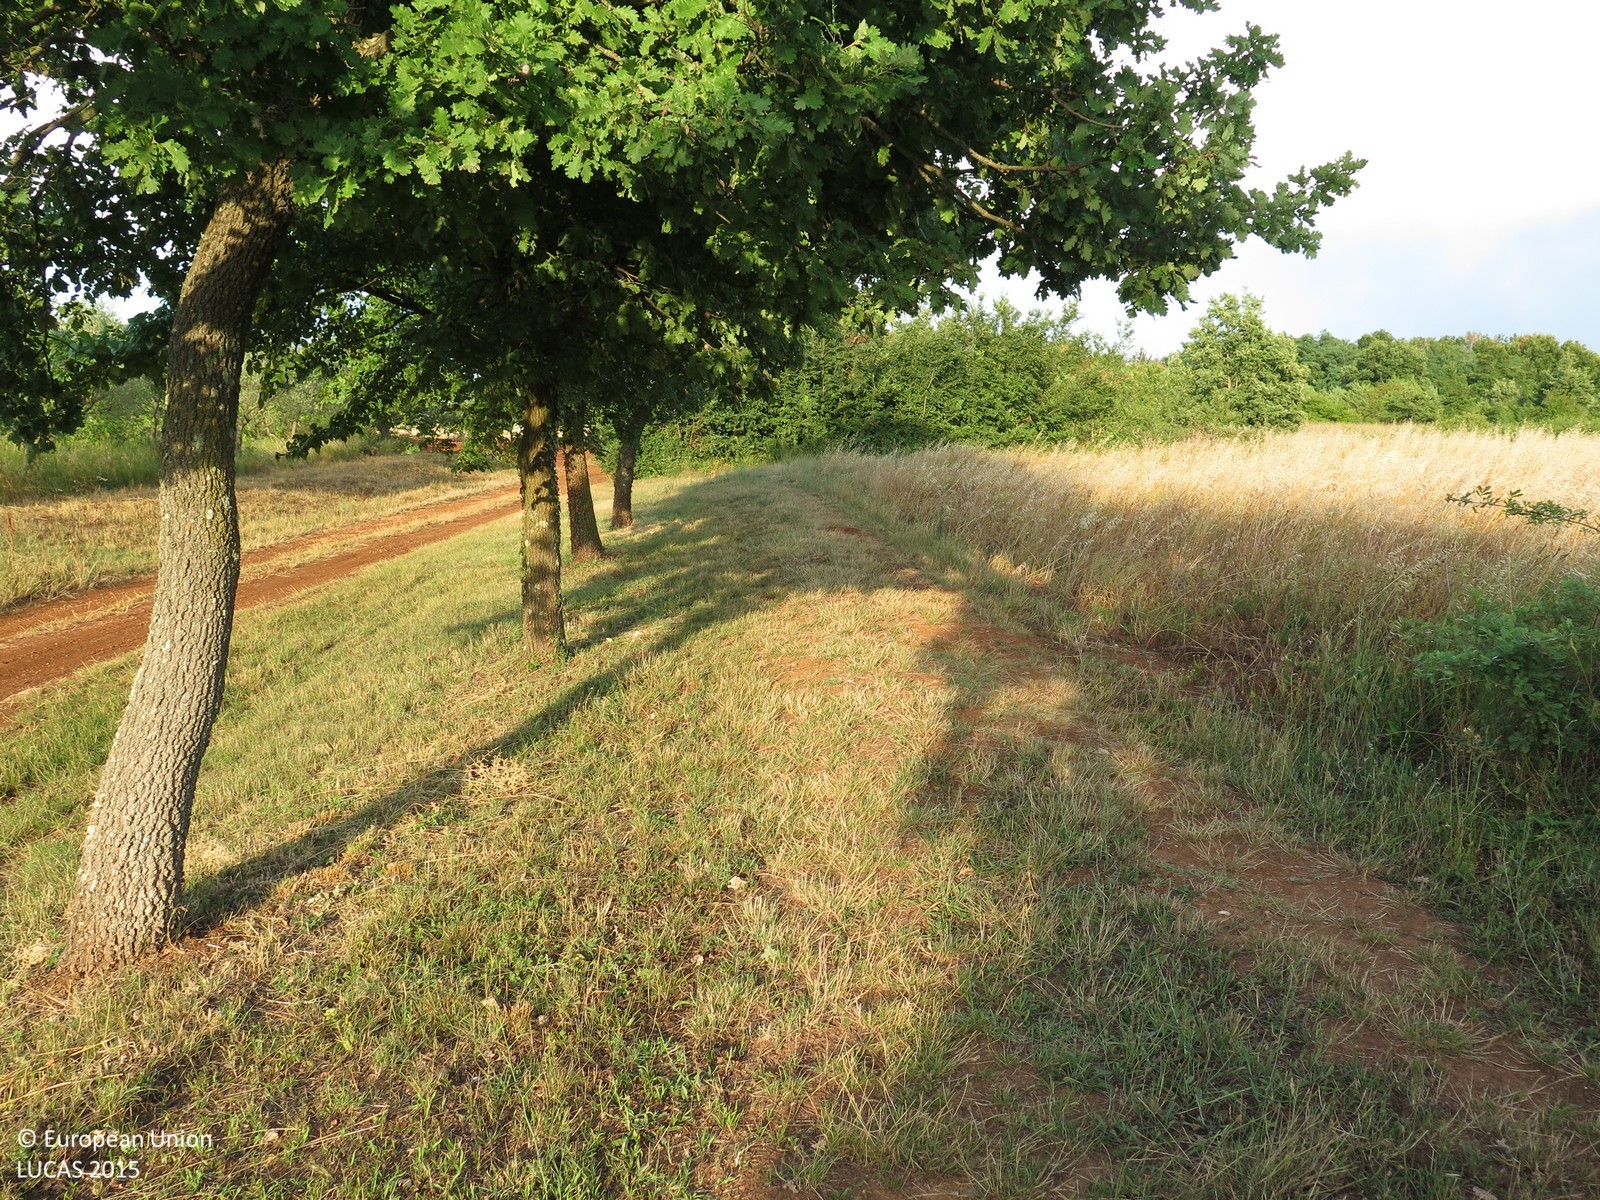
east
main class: Grassland
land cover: Grassland without tree/shrub cover
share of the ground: > 75 %
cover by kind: herbaceous plants 100 %
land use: Agriculture (excluding fallow land and kitchen gardens)
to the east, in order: Grassland without tree/shrub cover; Lines of trees; Grass margins; Tracks; Olive groves; Other bare soil; Other fresh vegetables; Maize; Other fresh vegetables; Vineyards; Other fresh vegetables; Other fruit trees and berries; Nuts trees; Apple fruit
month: June
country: HR
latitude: 45.2069
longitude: 13.6488
